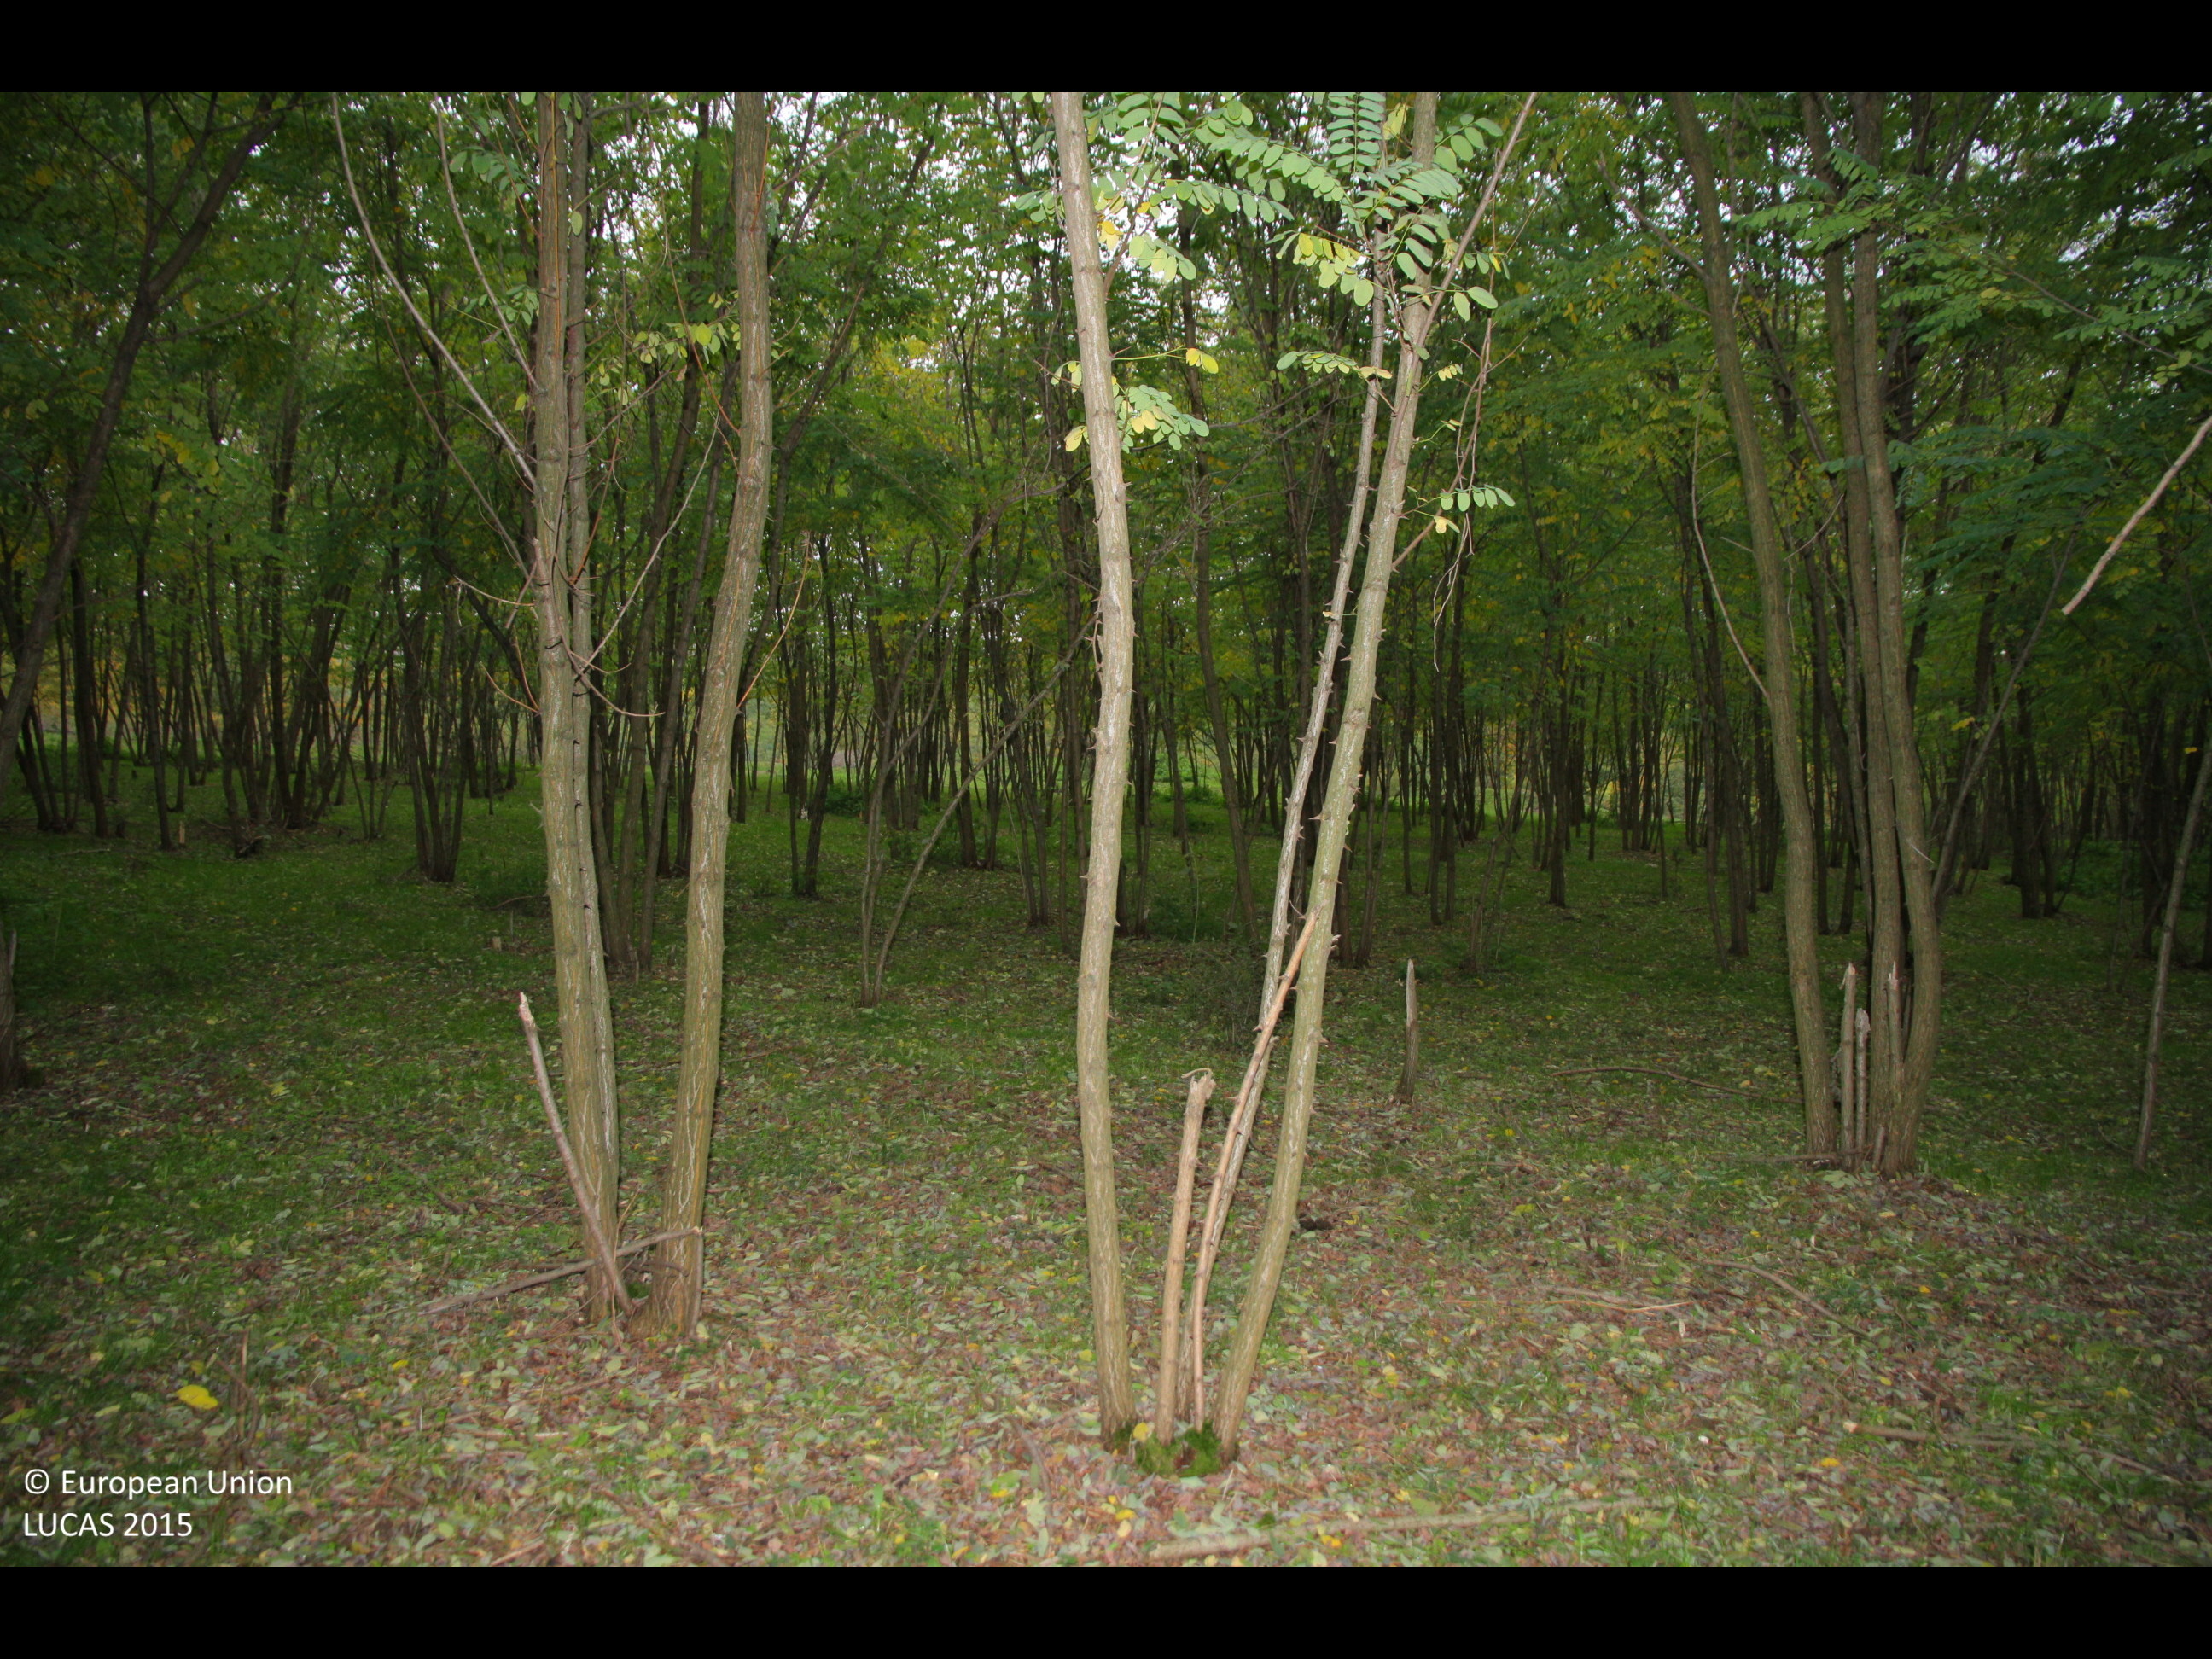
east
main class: Woodland
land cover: Broadleaved woodland
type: thermophilous deciduous forest
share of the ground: > 75 %
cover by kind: broadleaved forest trees 100 %
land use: Forestry
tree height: > 5 m
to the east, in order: Broadleaved woodland; Tracks; Broadleaved woodland; Tracks; Broadleaved woodland
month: October
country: BG
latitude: 43.6808
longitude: 27.0532
